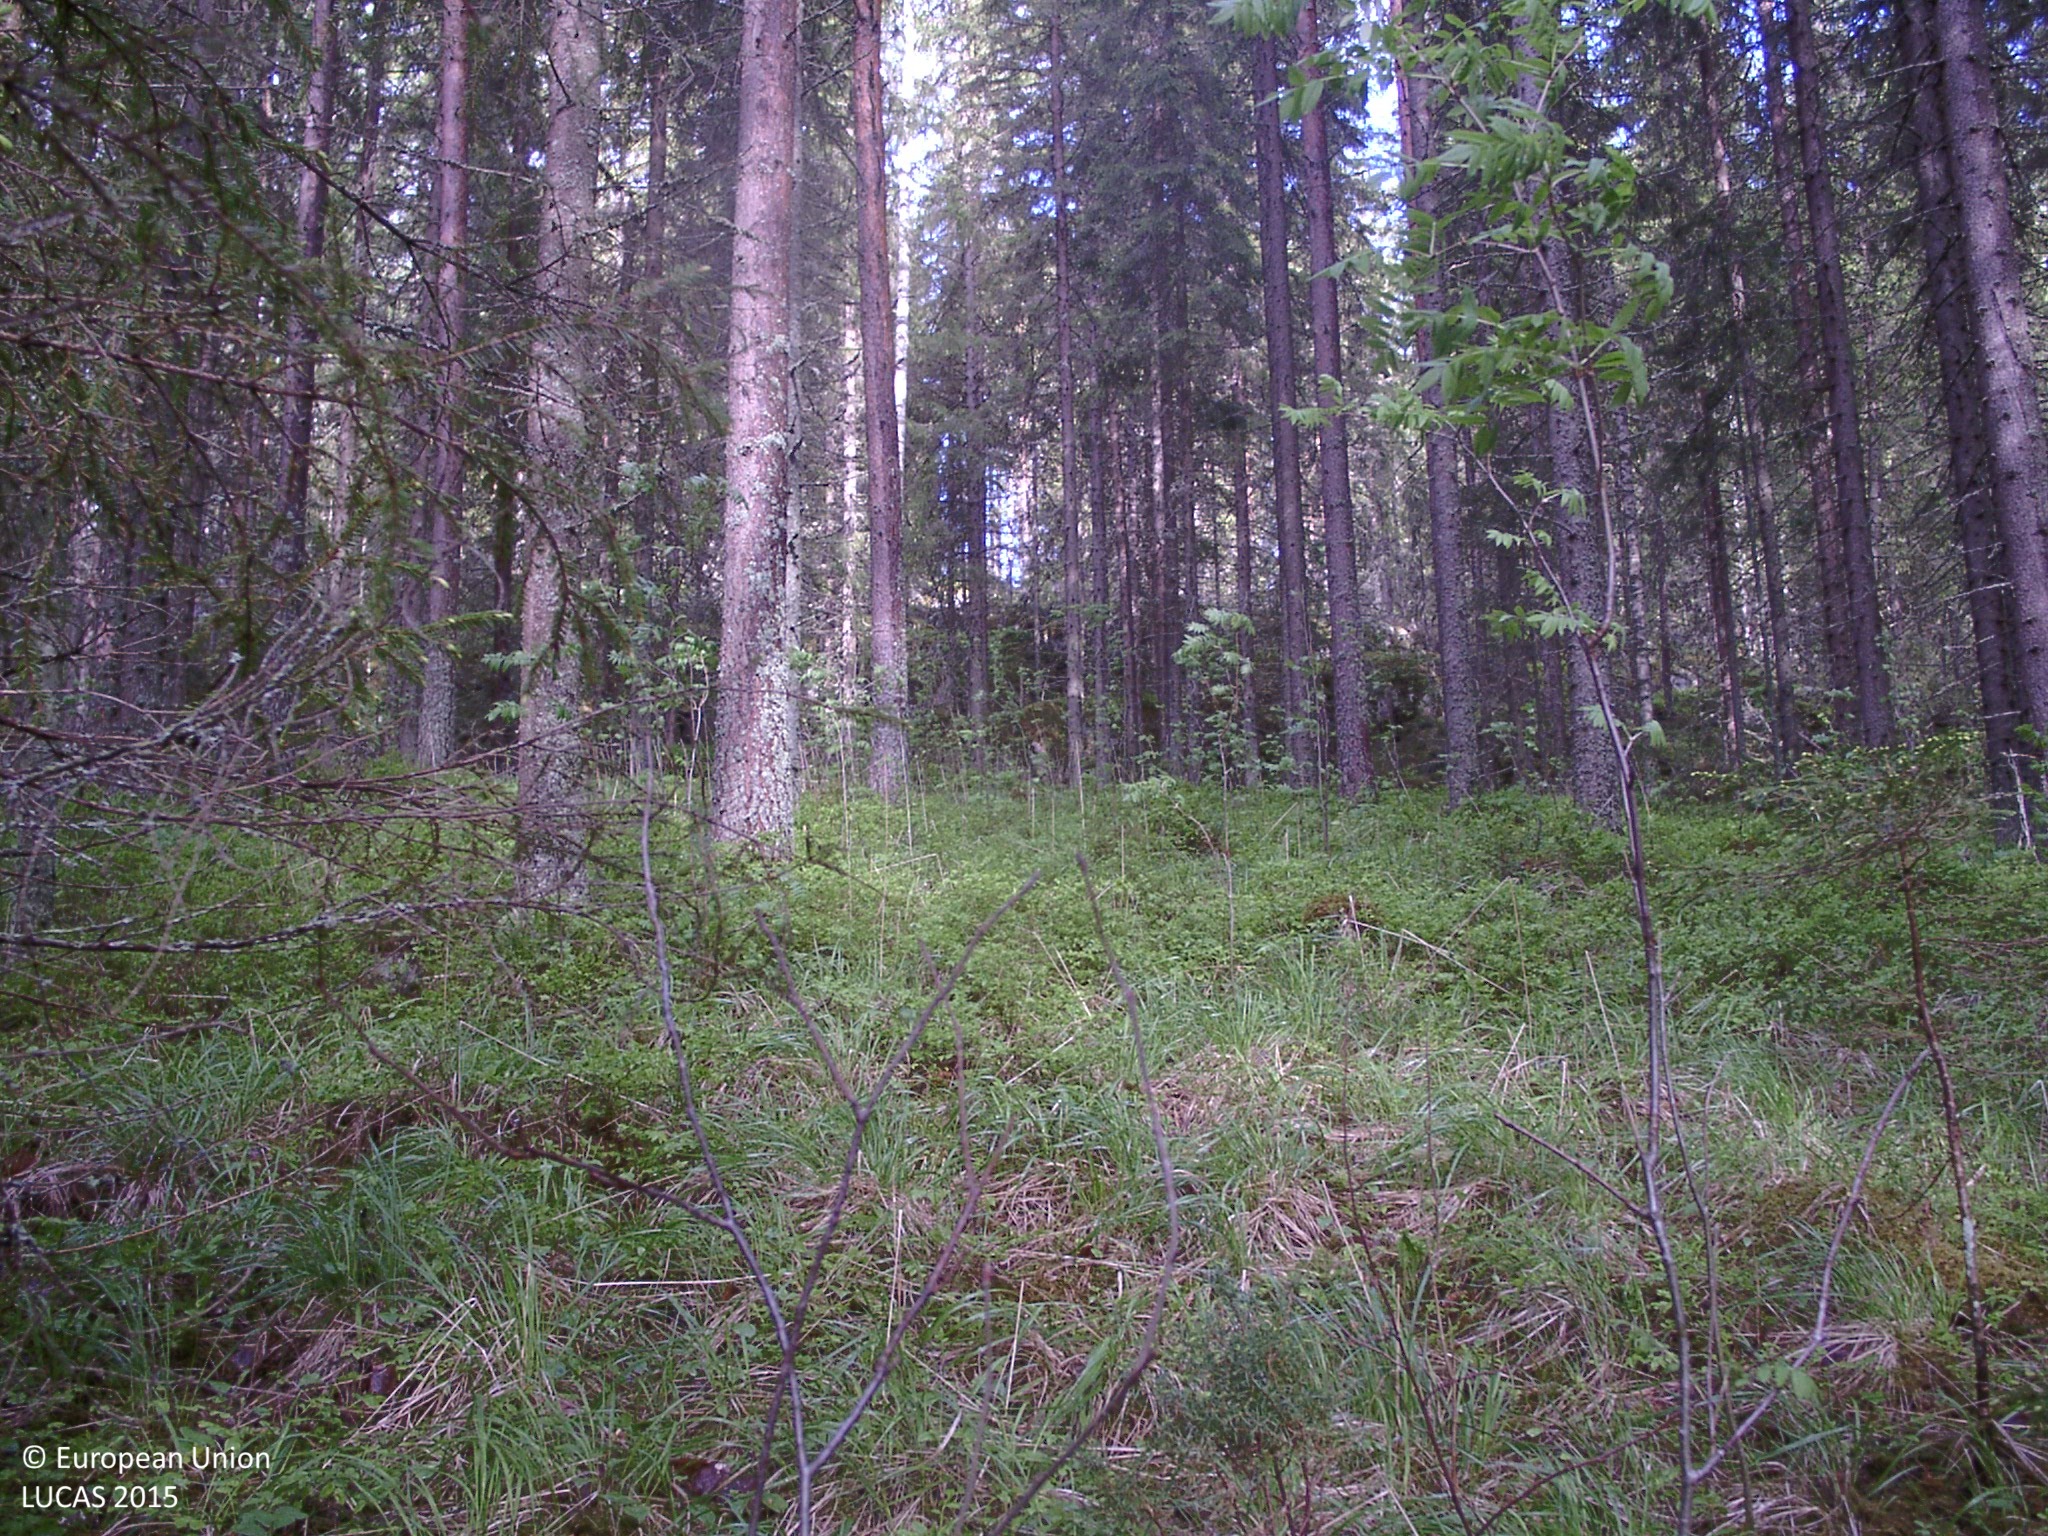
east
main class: Woodland
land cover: Spruce dominated coniferous woodland
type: boreal forest
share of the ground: 50 - 75 %
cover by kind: coniferous forest trees 65 %, shrubs 15 %, herbaceous plants 10 %, broadleaved forest trees 5 %, lichens and mosses 5 %
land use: Forestry
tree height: > 5 m
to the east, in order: Spruce dominated coniferous woodland; Pine dominated coniferous woodland; Other coniferous woodland; Spruce dominated coniferous woodland
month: June
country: FI
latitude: 62.1891
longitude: 25.5045
